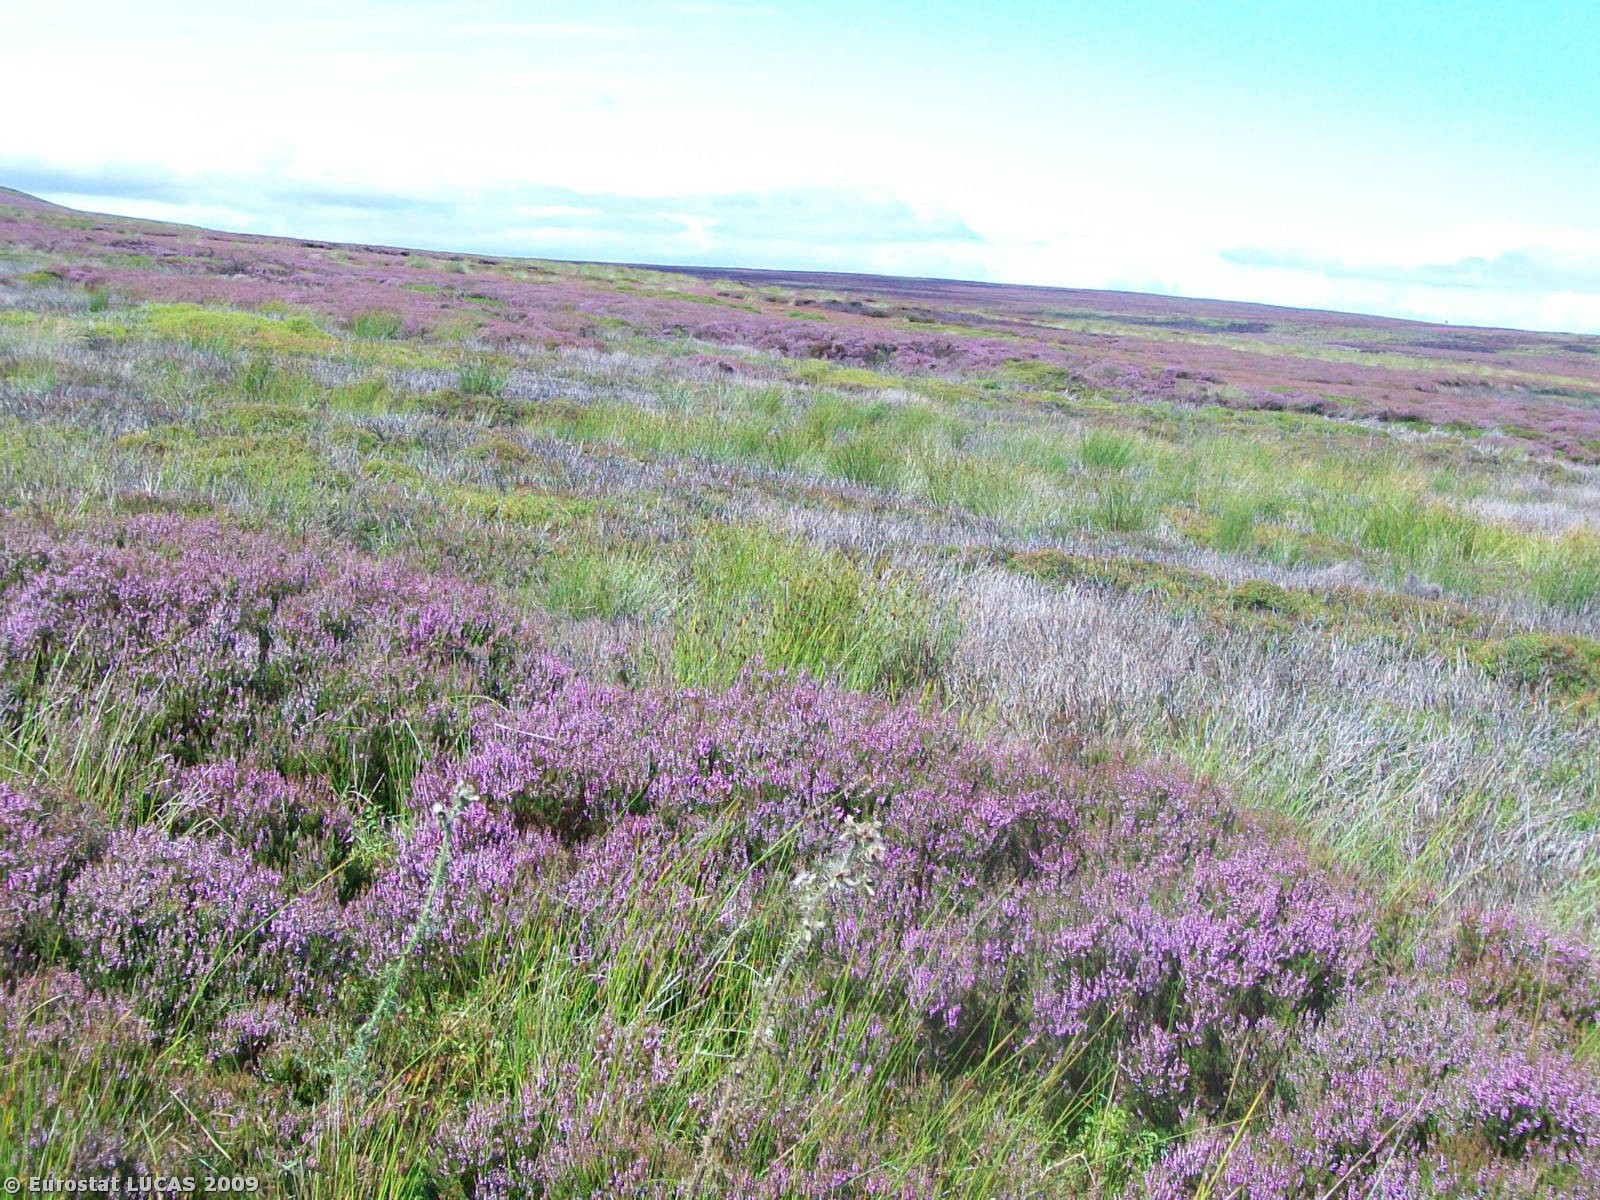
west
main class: Shrubland
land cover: Shrubland without tree cover
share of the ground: > 75 %
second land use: Nature reserves
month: August
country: GB
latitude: 54.1530
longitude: -1.7665
